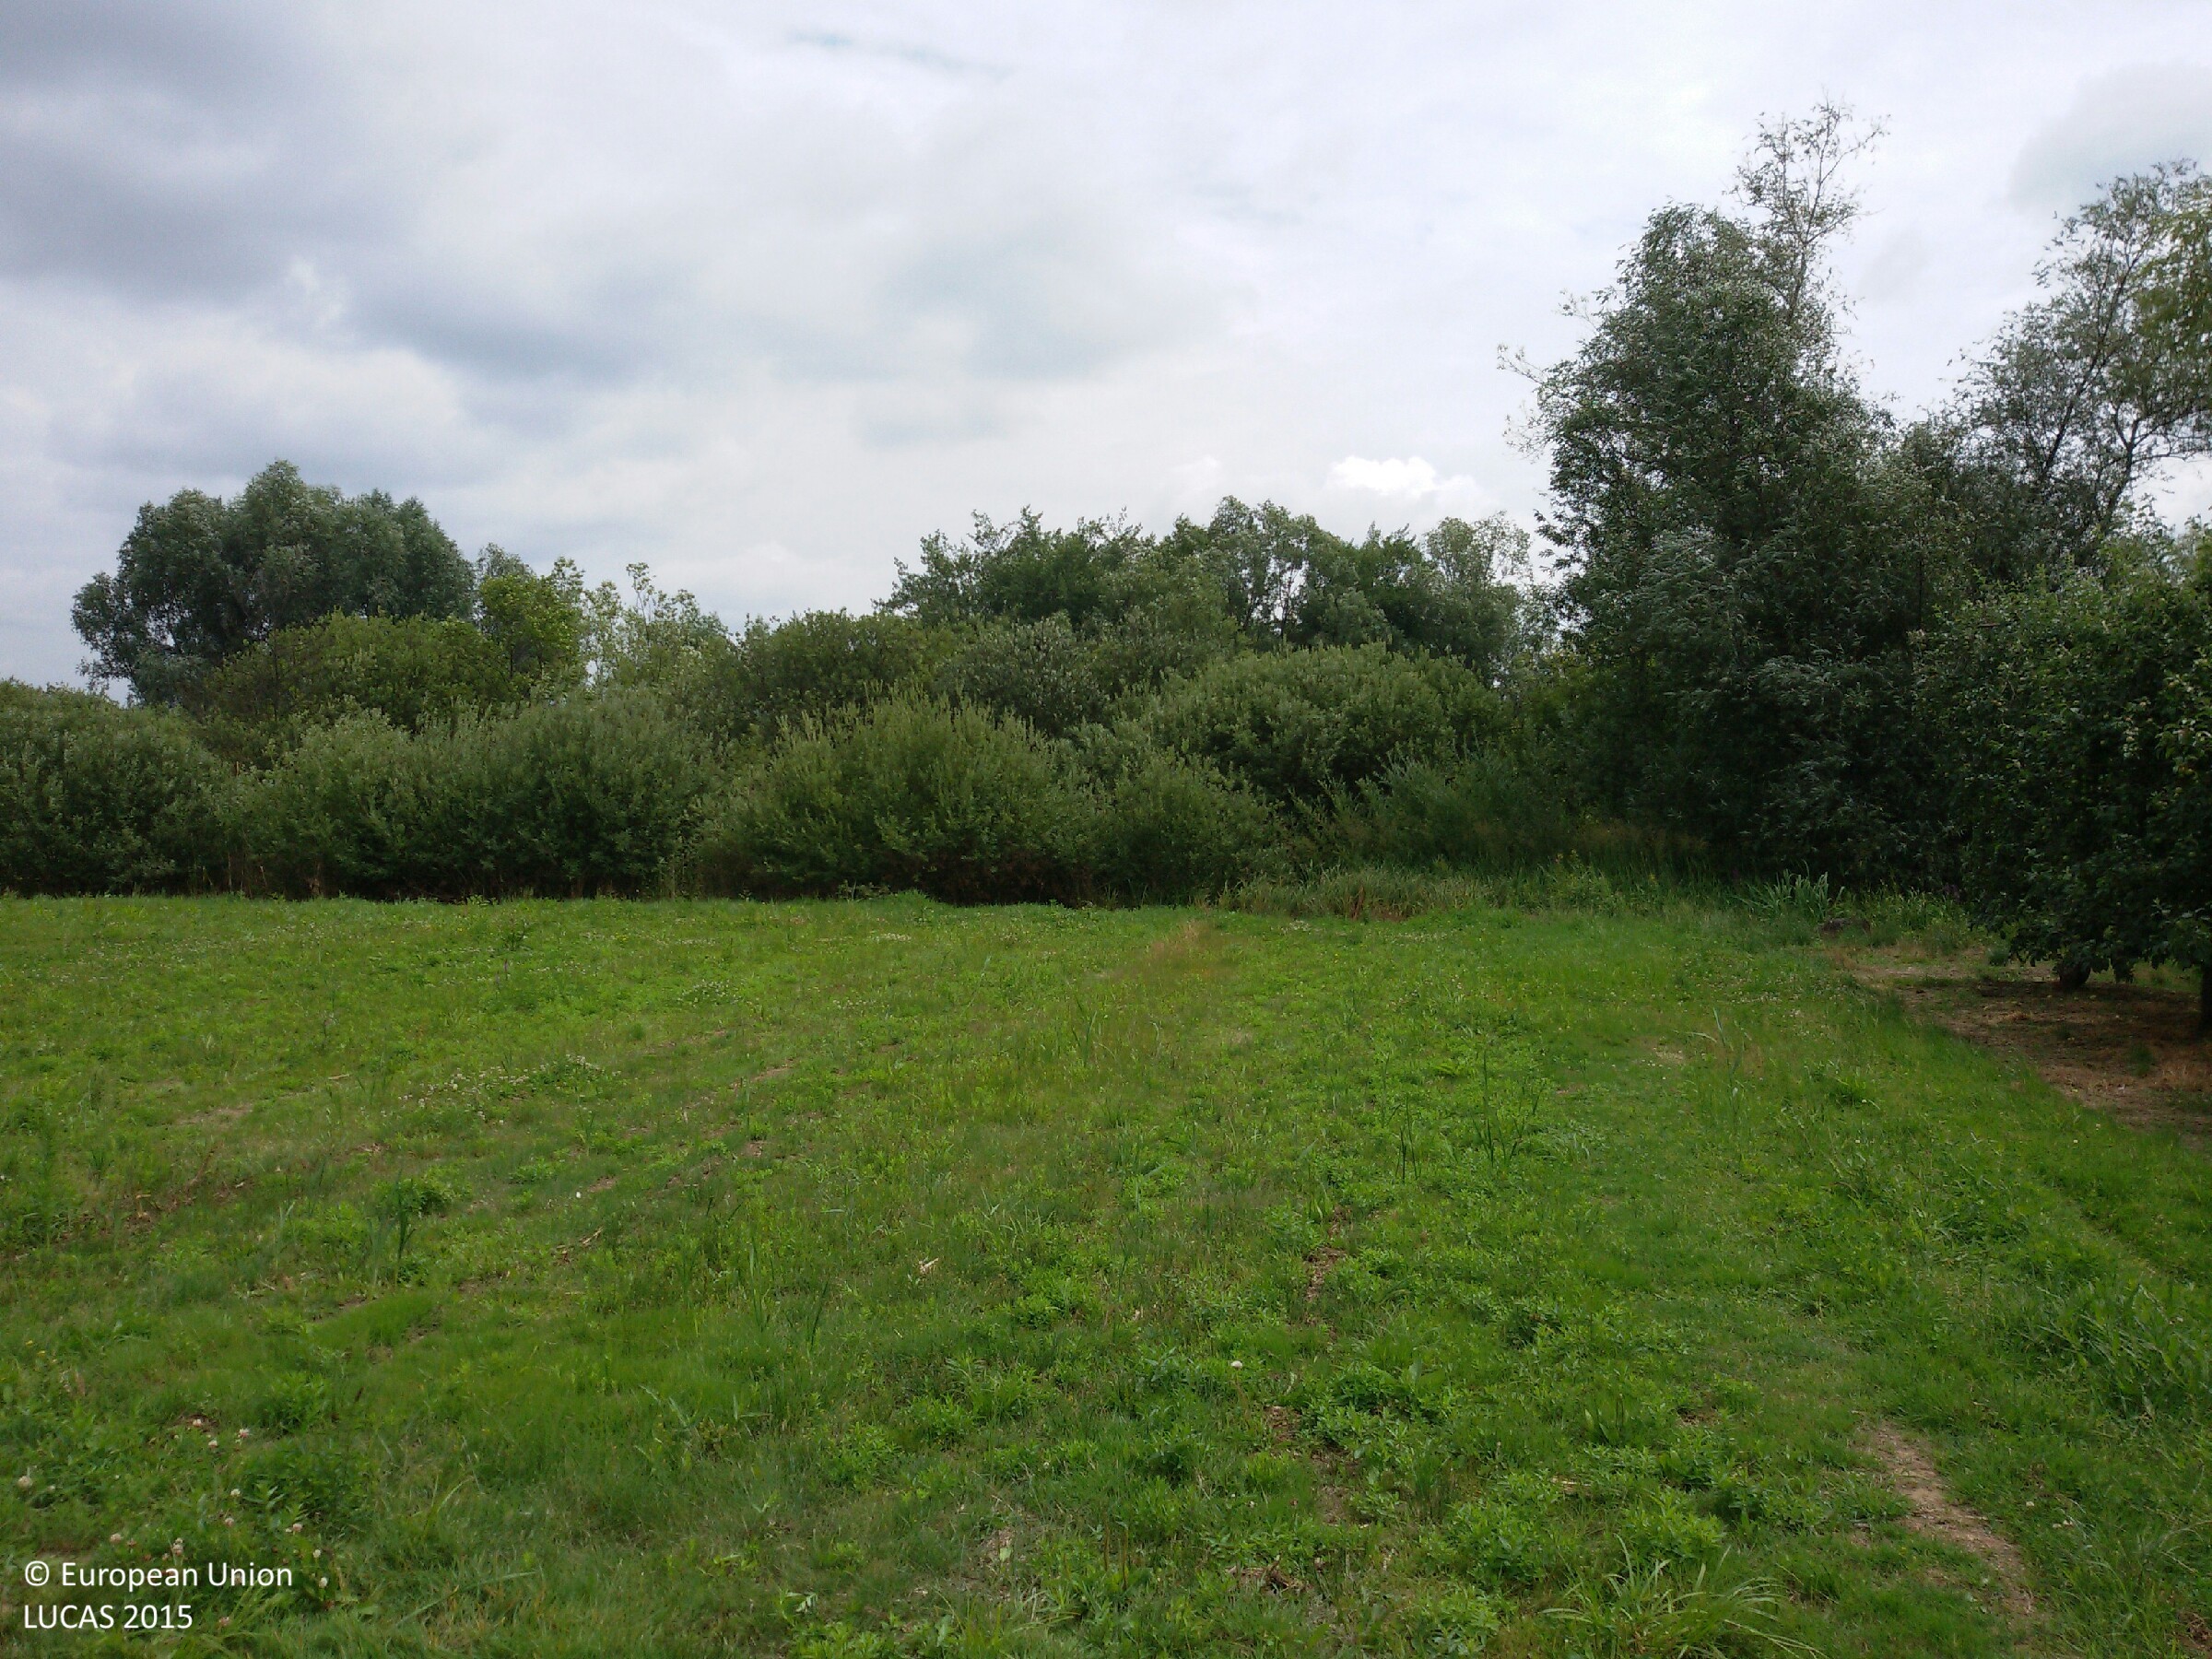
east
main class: Grassland
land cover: Grassland without tree/shrub cover
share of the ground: > 75 %
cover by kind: herbaceous plants 100 %
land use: Agriculture (excluding fallow land and kitchen gardens)
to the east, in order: Grassland without tree/shrub cover; Spontaneously vegetated surfaces; Inland marshes; Spontaneously vegetated surfaces; Inland fresh running water; Spontaneously vegetated surfaces; Grassland with sparse tree/shrub cover
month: July
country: PL
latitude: 51.2013
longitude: 21.8346
